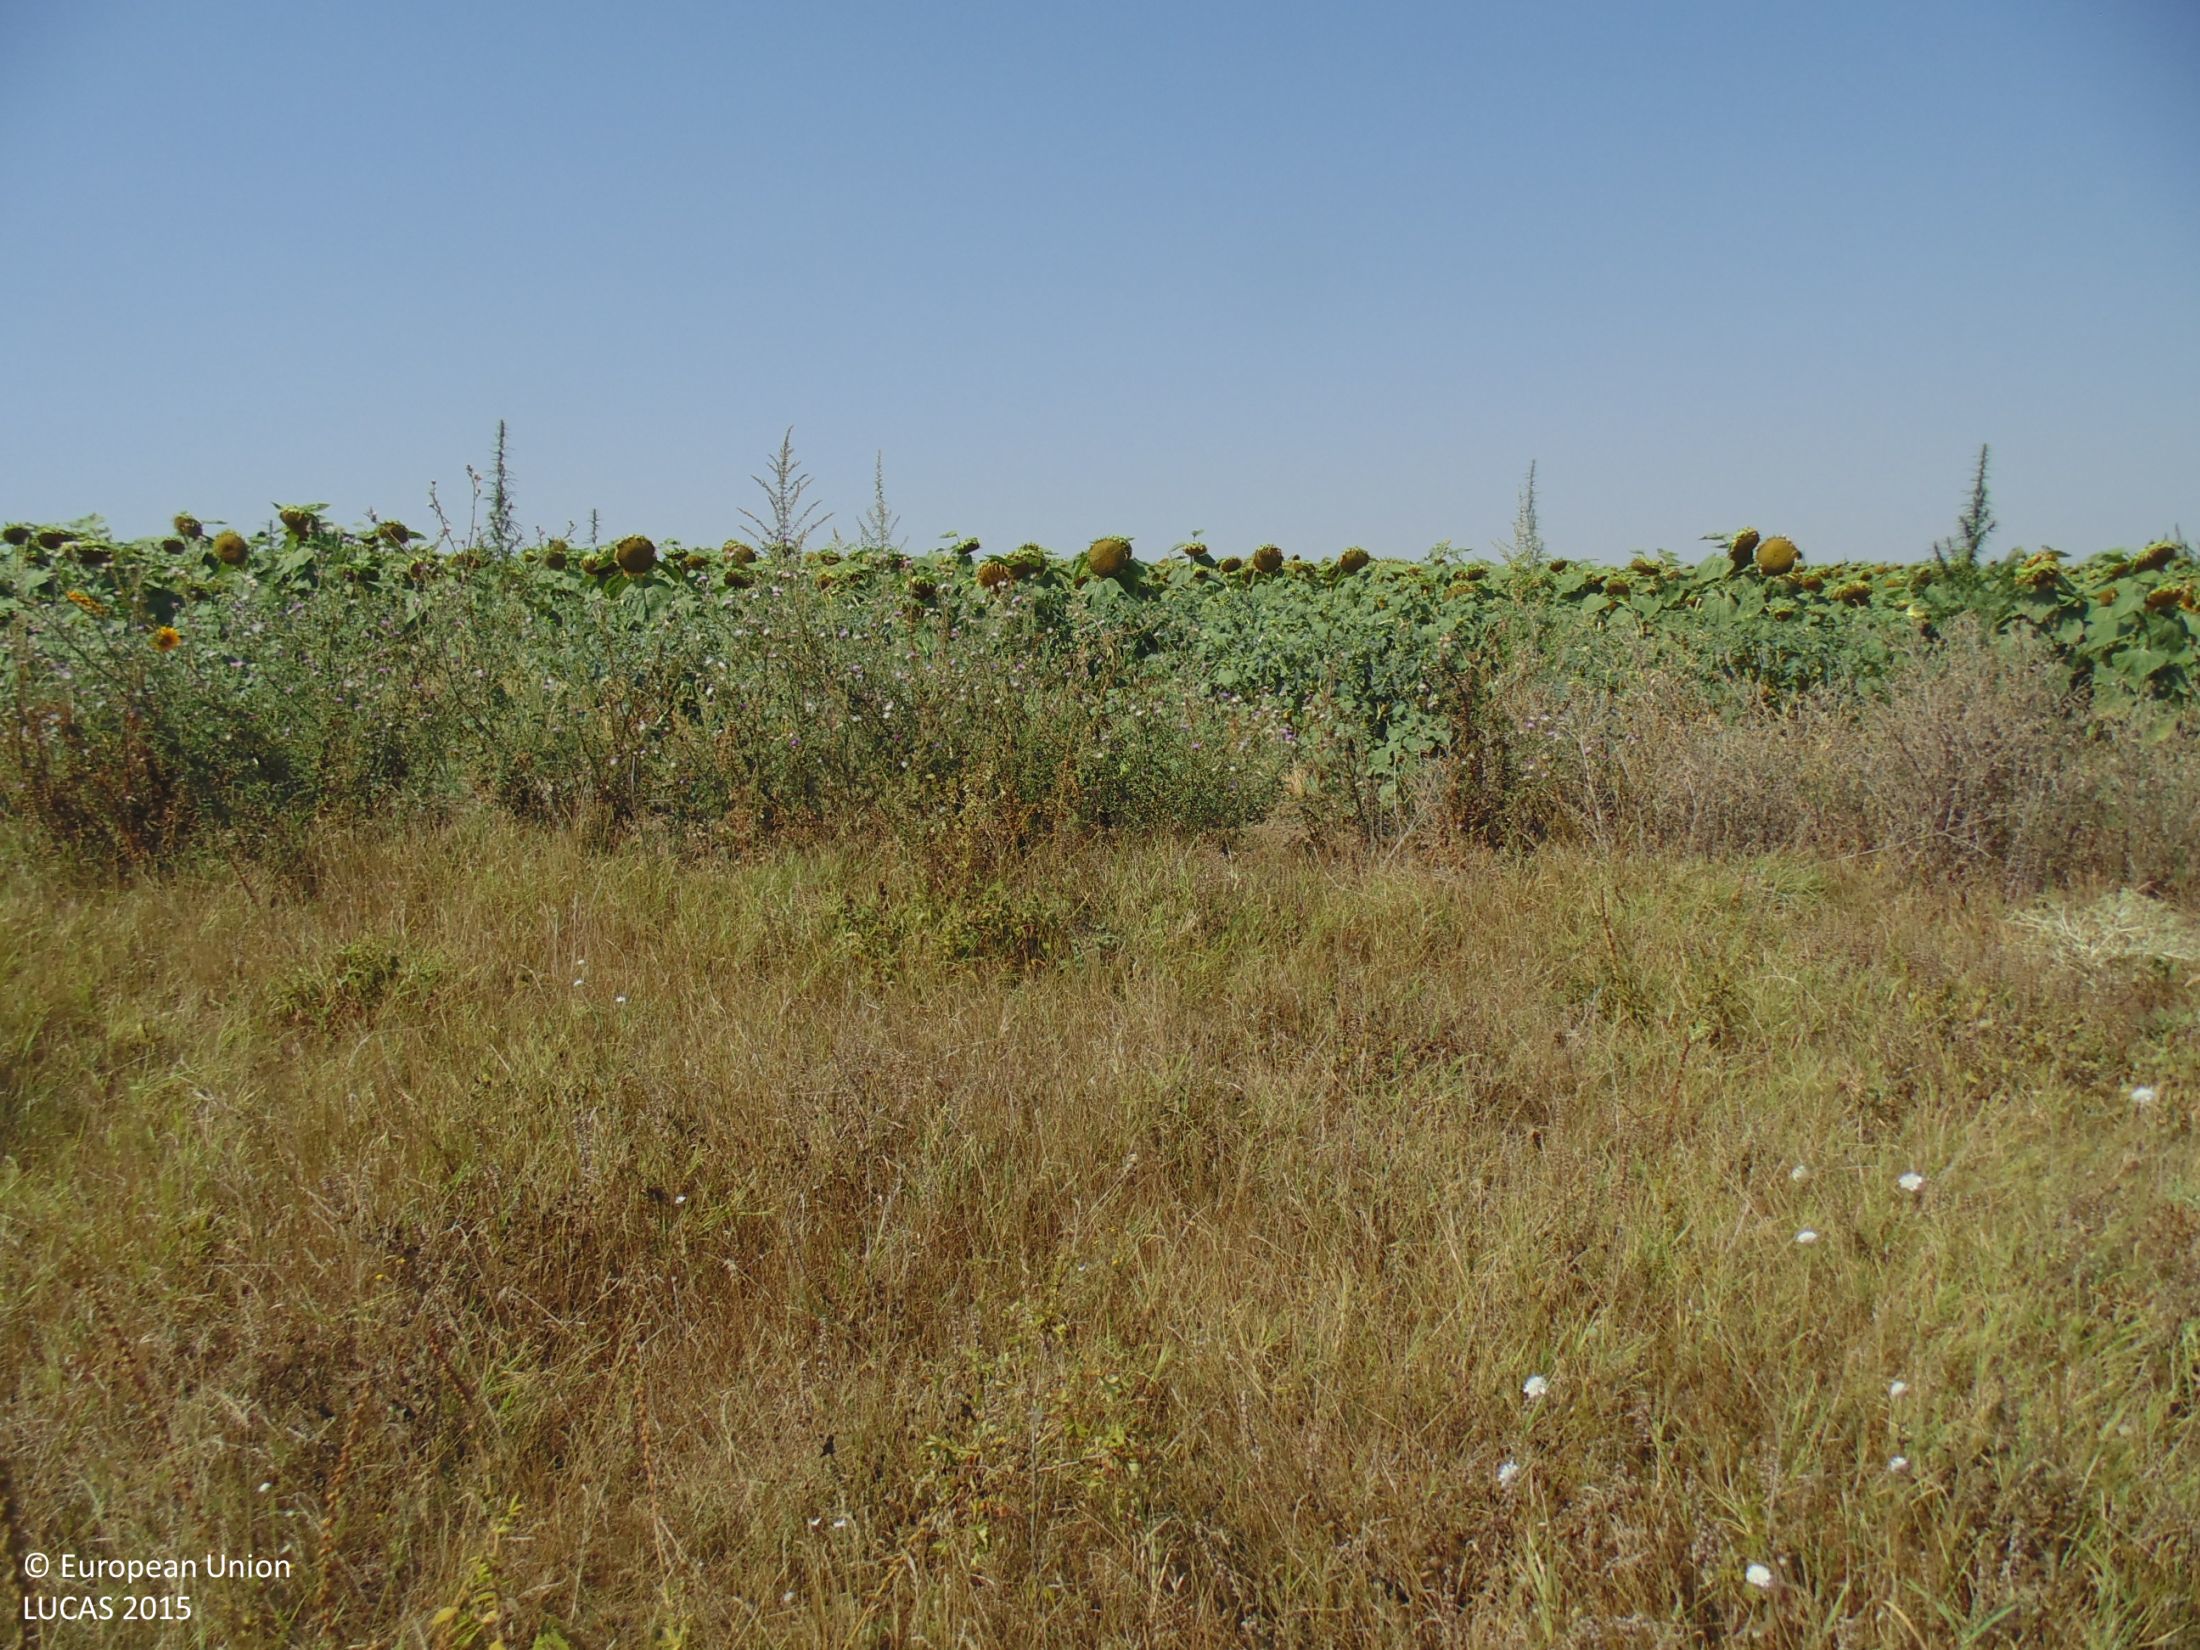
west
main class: Grassland
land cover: Grassland with sparse tree/shrub cover
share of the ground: > 75 %
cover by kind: herbaceous plants 90 %, broadleaved forest trees 5 %, shrubs 5 %
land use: Agriculture (excluding fallow land and kitchen gardens)
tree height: < 5 m
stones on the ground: < 10 %
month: August
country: BG
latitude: 43.9819
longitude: 27.5550
